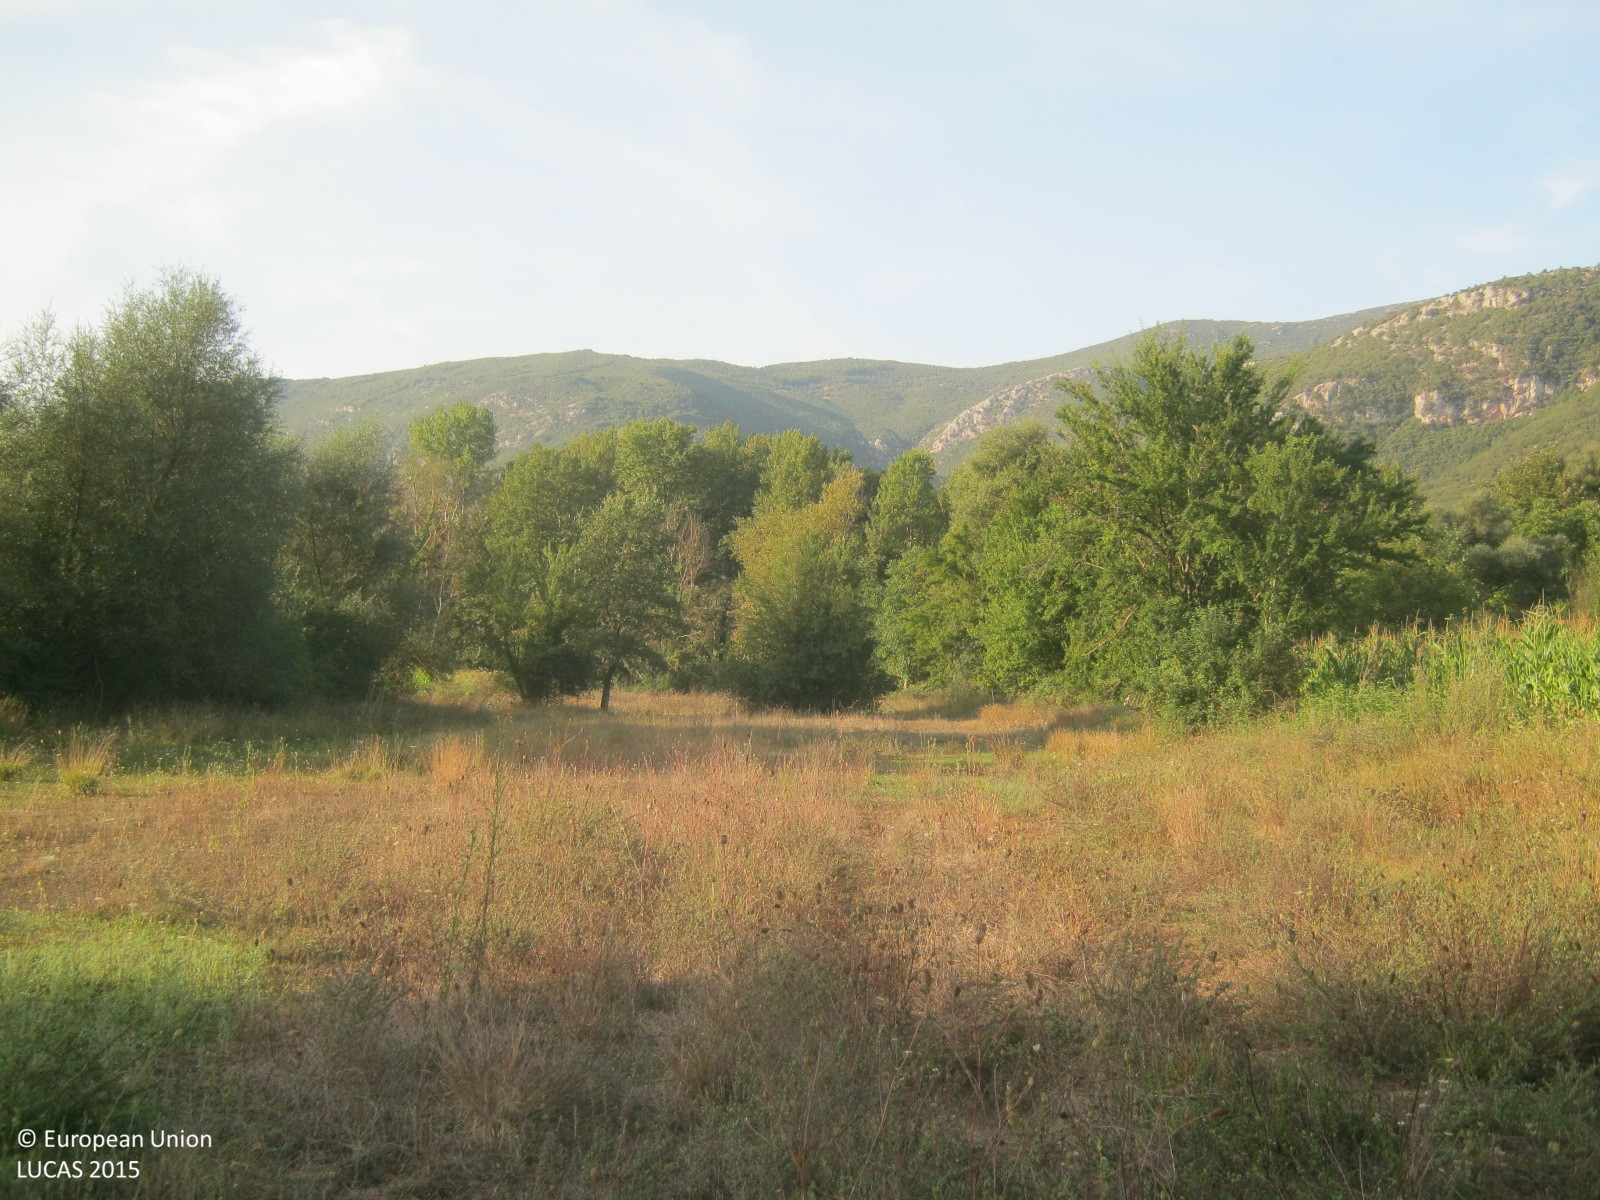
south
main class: Grassland
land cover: Spontaneously vegetated surfaces
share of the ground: > 75 %
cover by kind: herbaceous plants 90 %, shrubs 5 %, unconsolidated bare surface 5 %
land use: Fallow land
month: September
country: GR
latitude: 37.8821
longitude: 22.1424
